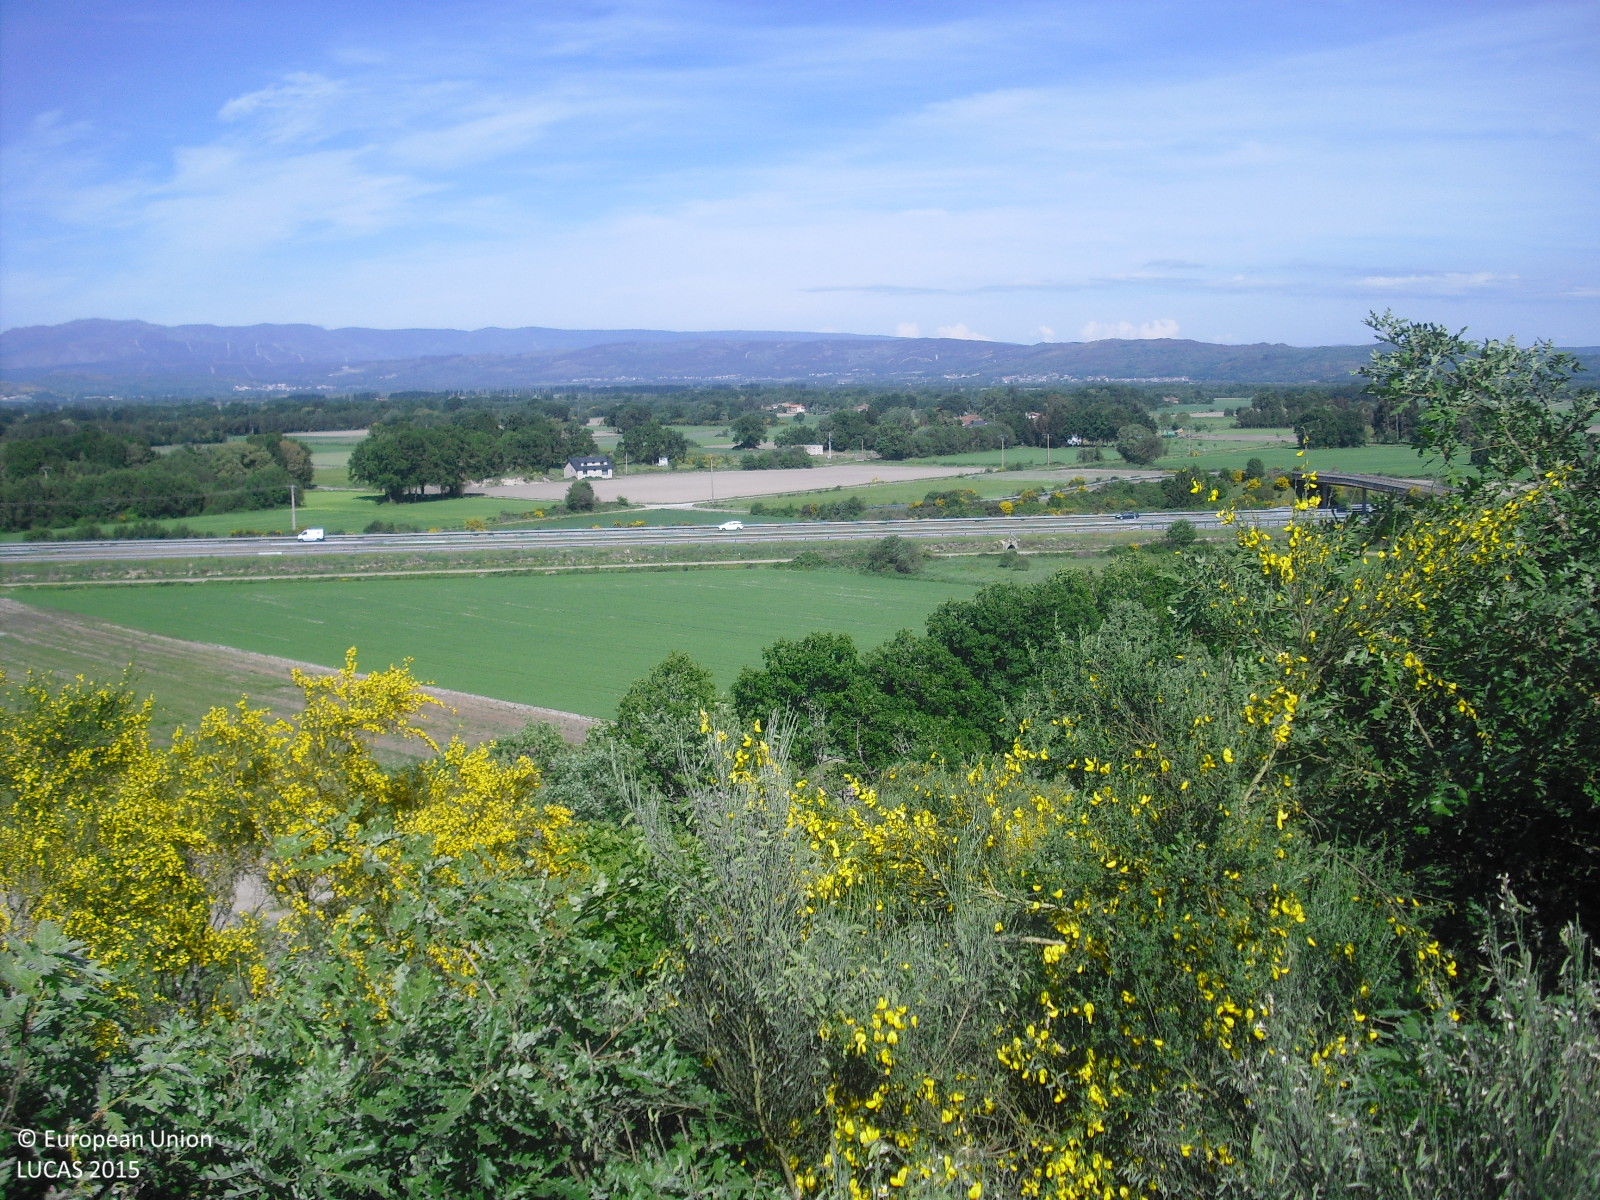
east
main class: Woodland
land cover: Broadleaved woodland
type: acidophilous oak and oak-birch forest
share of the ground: 25 - 50 %
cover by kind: shrubs 50 %, broadleaved forest trees 40 %, herbaceous plants 10 %
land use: Semi-natural and natural areas not in use
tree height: < 5 m
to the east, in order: Broadleaved woodland; Ditches and canals; Grass margins; Tracks; Grass margins; Nuts trees; Other bare soil; Nuts trees; Other bare soil; Common wheat
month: May
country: ES
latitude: 42.1240
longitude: -7.7435
